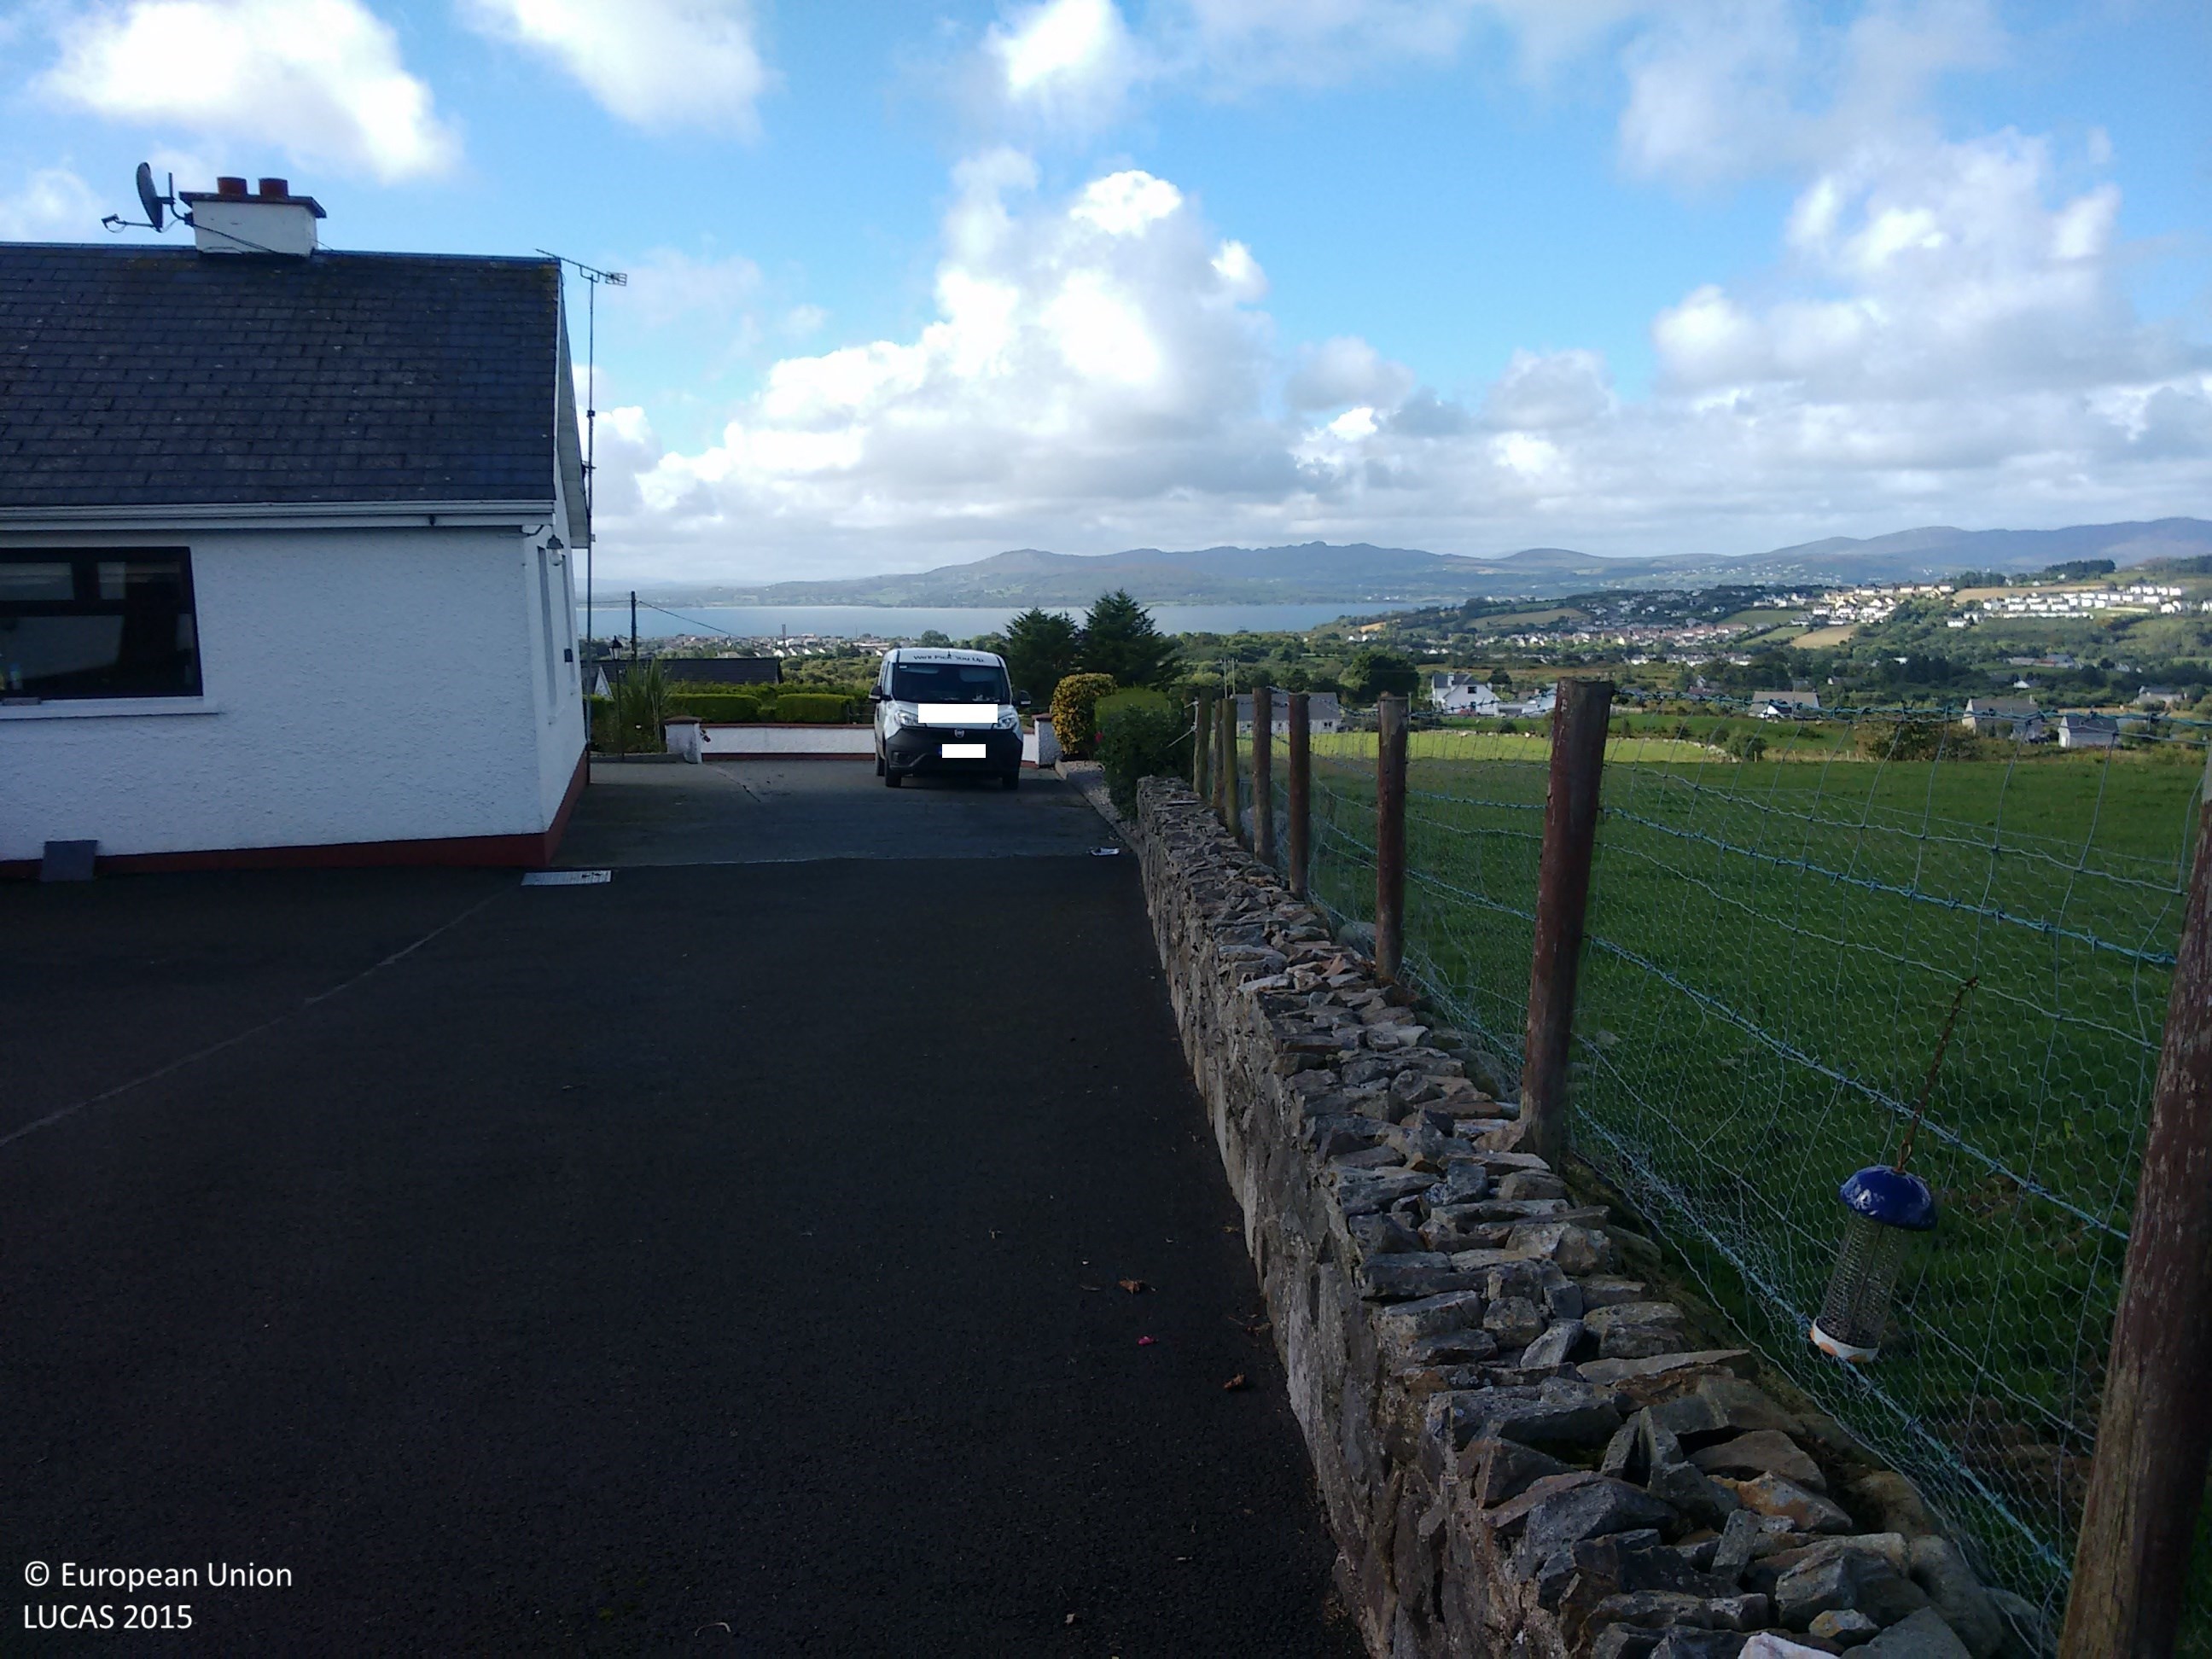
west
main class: Grassland
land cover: Grassland without tree/shrub cover
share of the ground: > 75 %
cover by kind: herbaceous plants 100 %
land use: Agriculture (excluding fallow land and kitchen gardens)
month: September
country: IE
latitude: 55.1469
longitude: -7.4262
